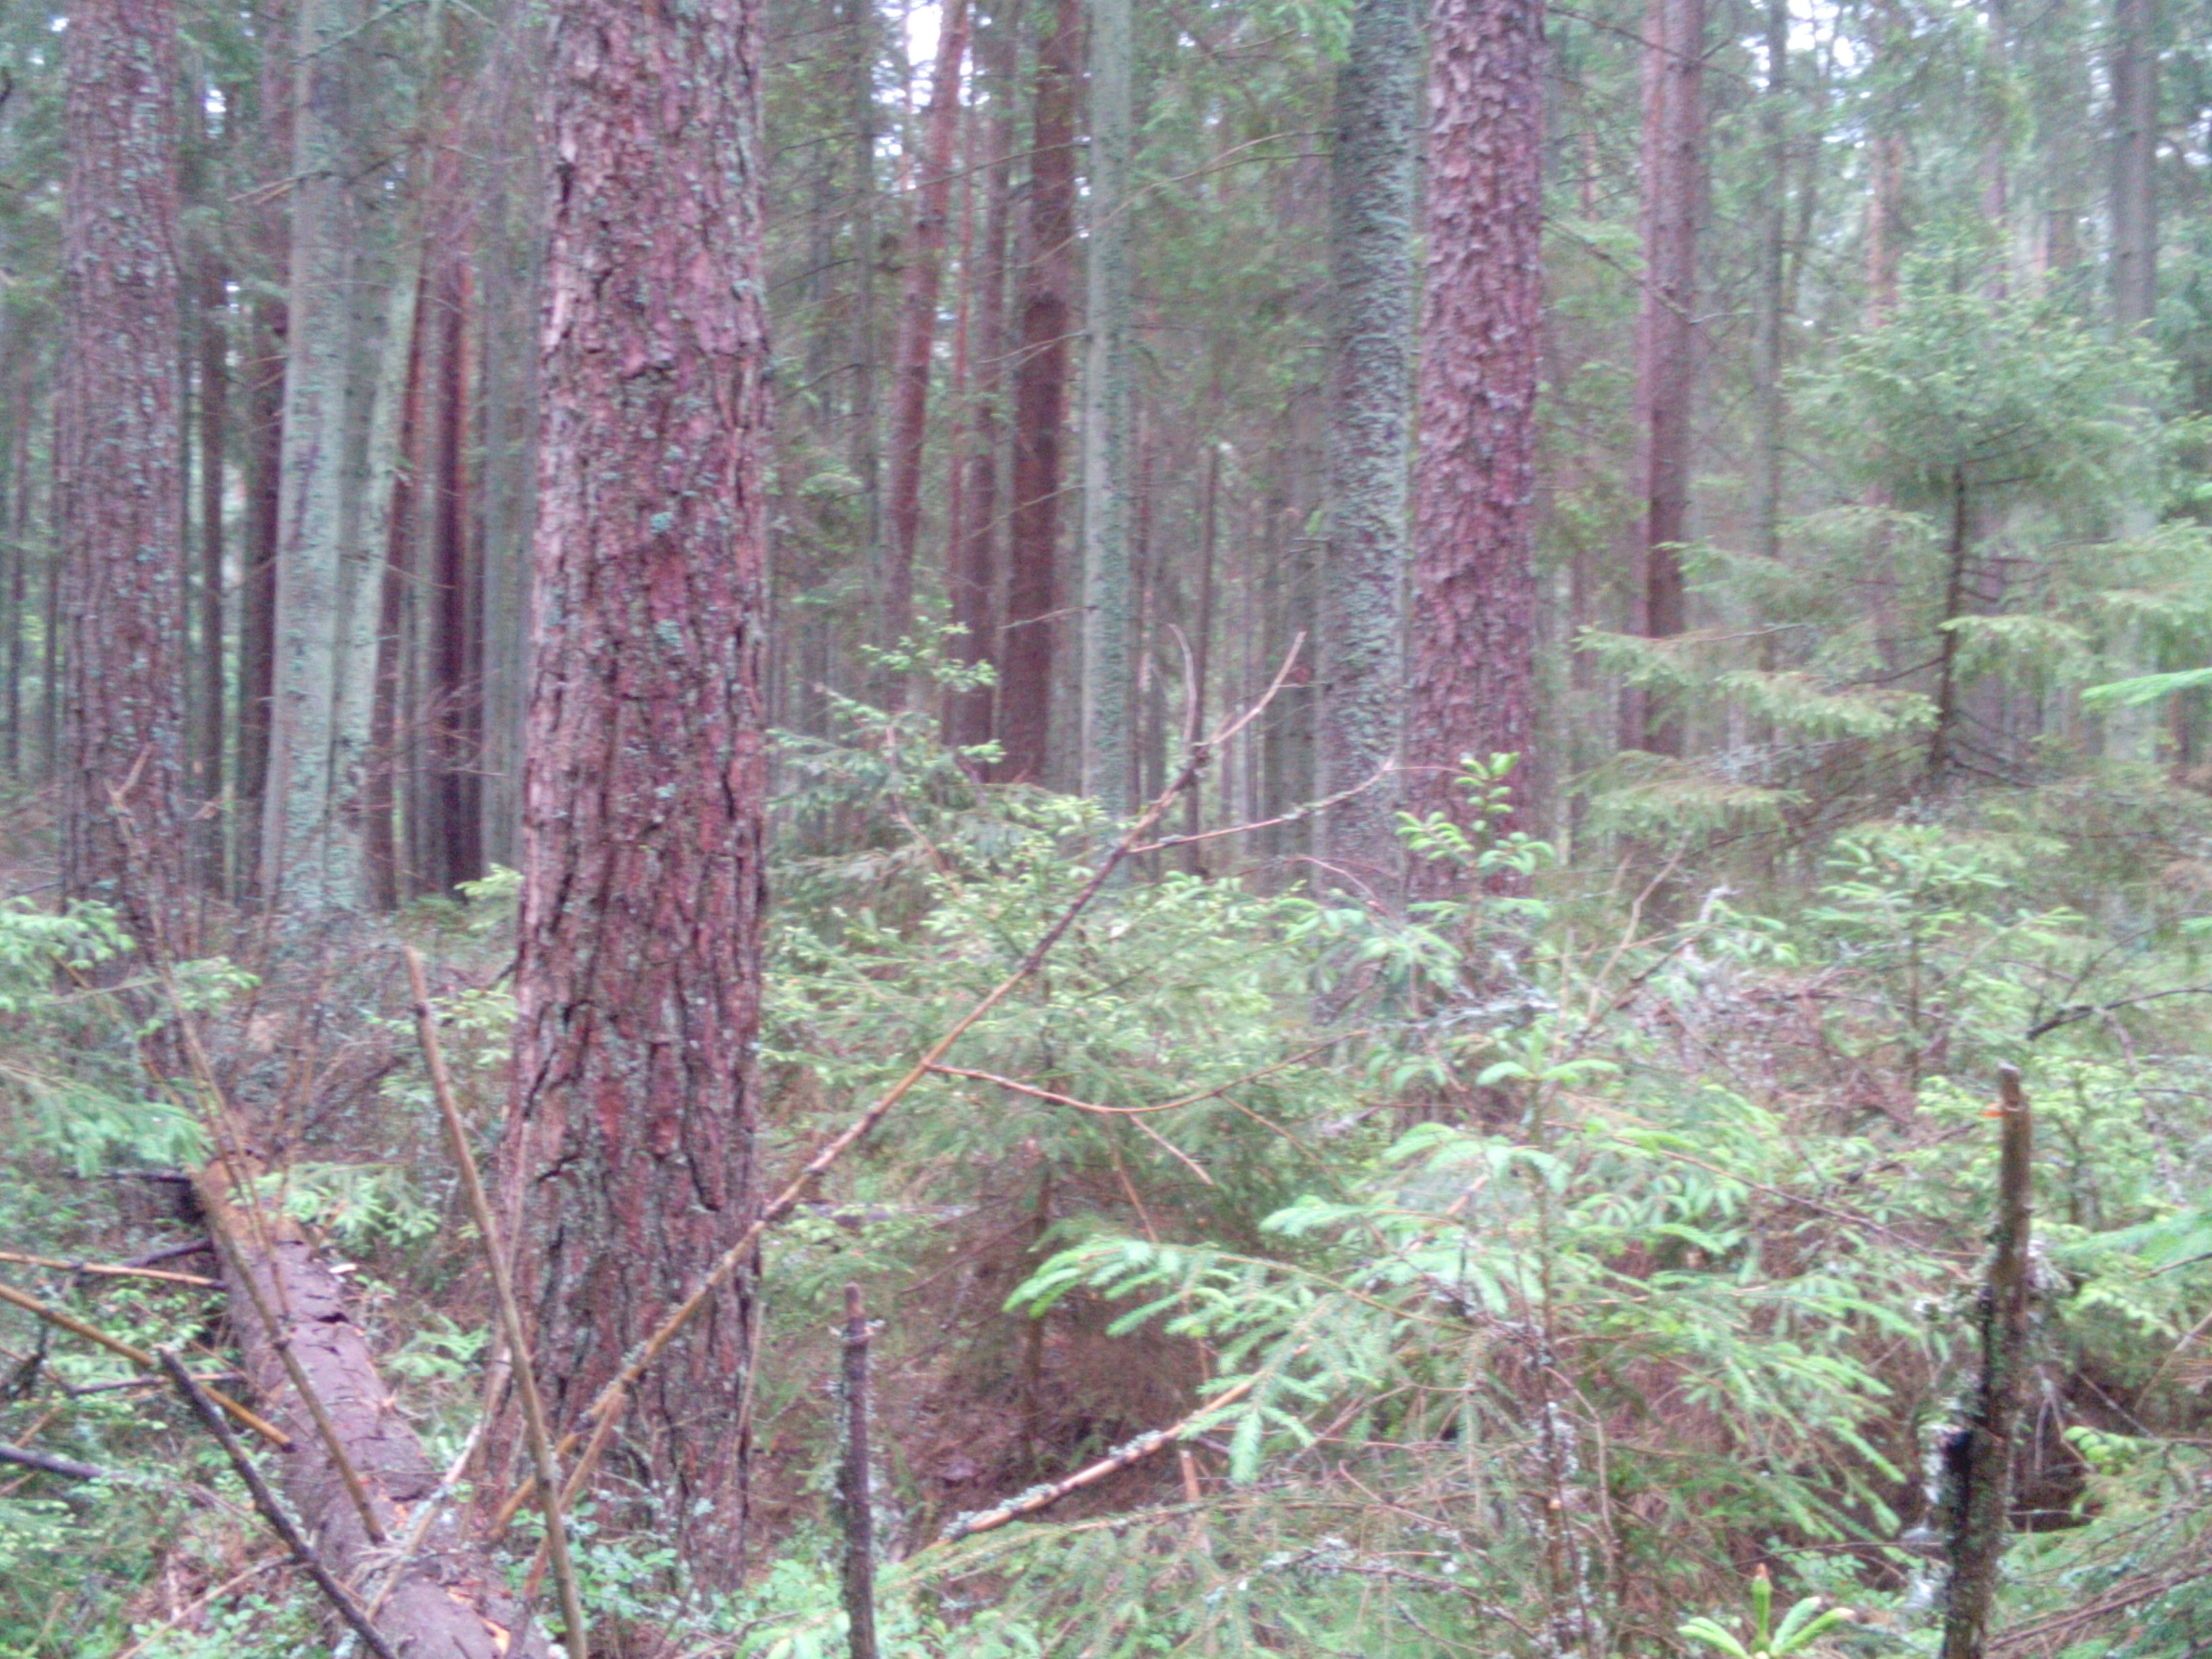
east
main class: Woodland
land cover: Other coniferous woodland
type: hemiboreal forest and nemoral coniferous forest and mixed broadleaved-coniferous forest
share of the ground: > 75 %
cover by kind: coniferous forest trees 90 %, herbaceous plants 10 %
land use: Forestry
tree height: > 5 m
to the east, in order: Other coniferous woodland; Spruce dominated coniferous woodland
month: June
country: LV
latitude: 56.7712
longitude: 21.9761
